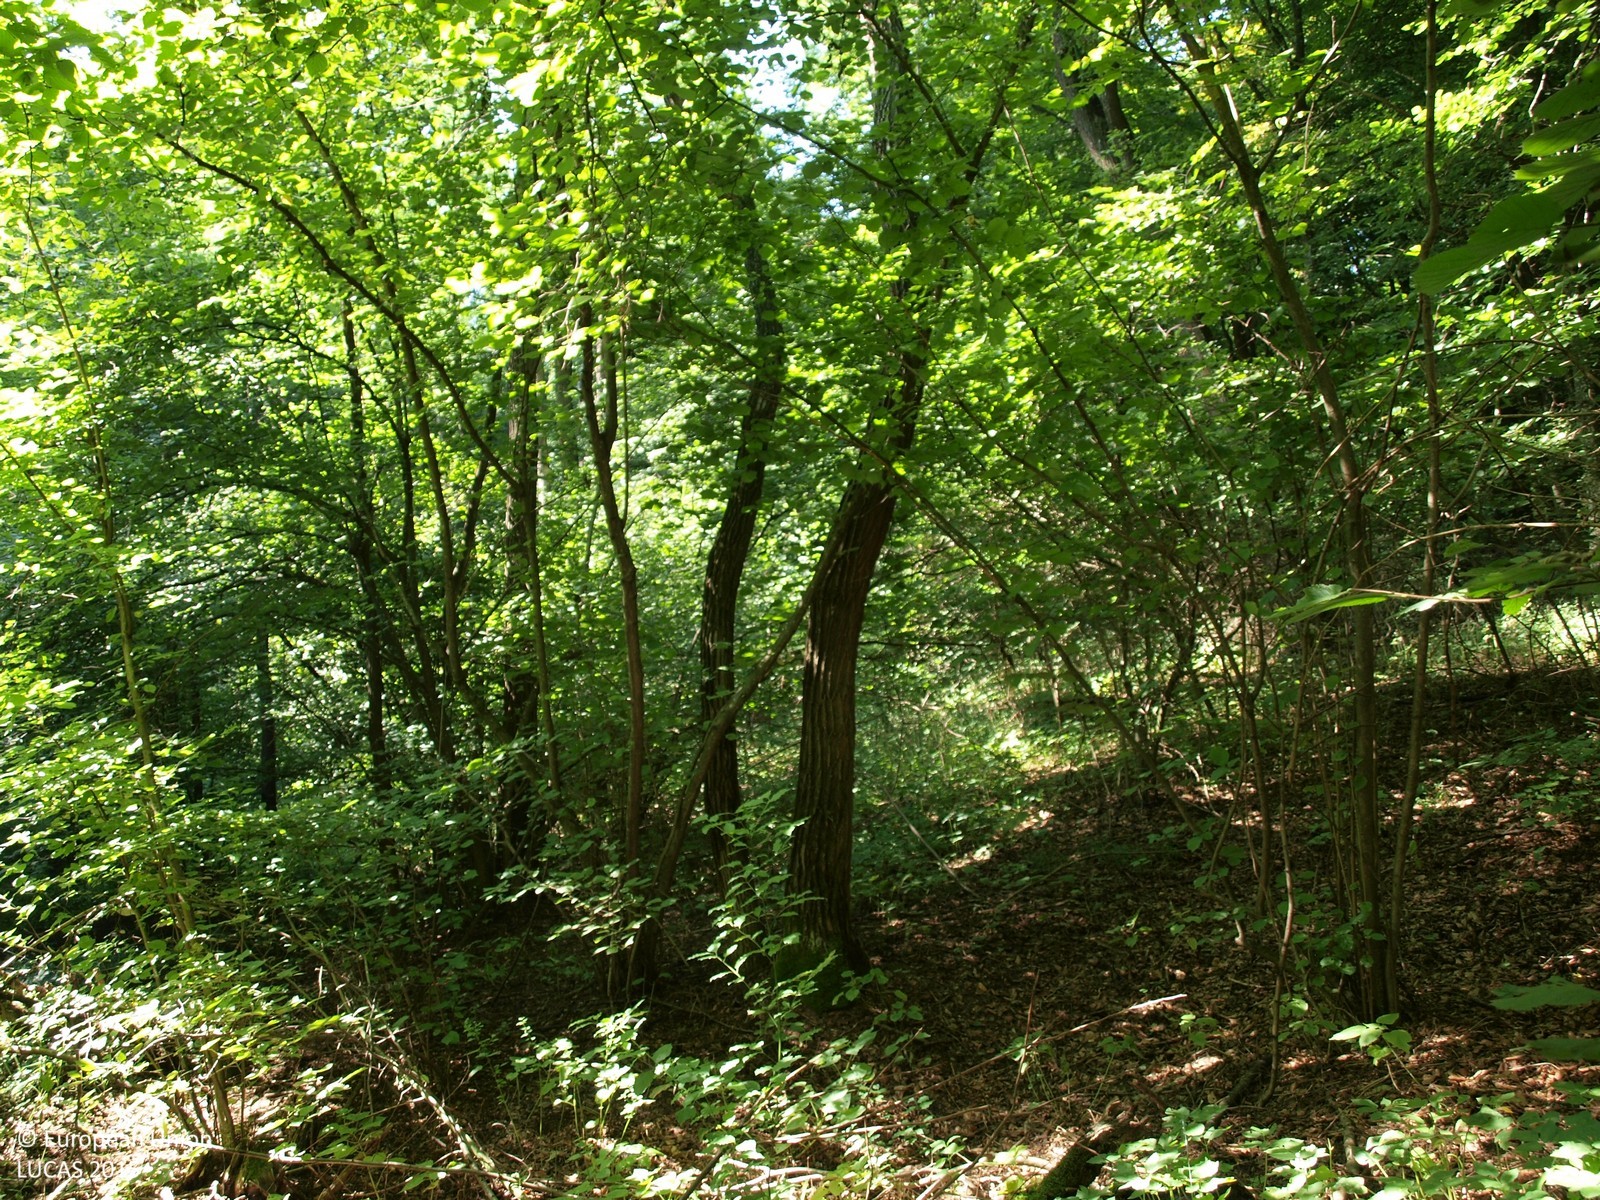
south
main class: Woodland
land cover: Broadleaved woodland
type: beech forest
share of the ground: > 75 %
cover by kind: broadleaved forest trees 100 %
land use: Forestry
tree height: > 5 m
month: August
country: HR
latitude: 46.1020
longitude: 16.4550
